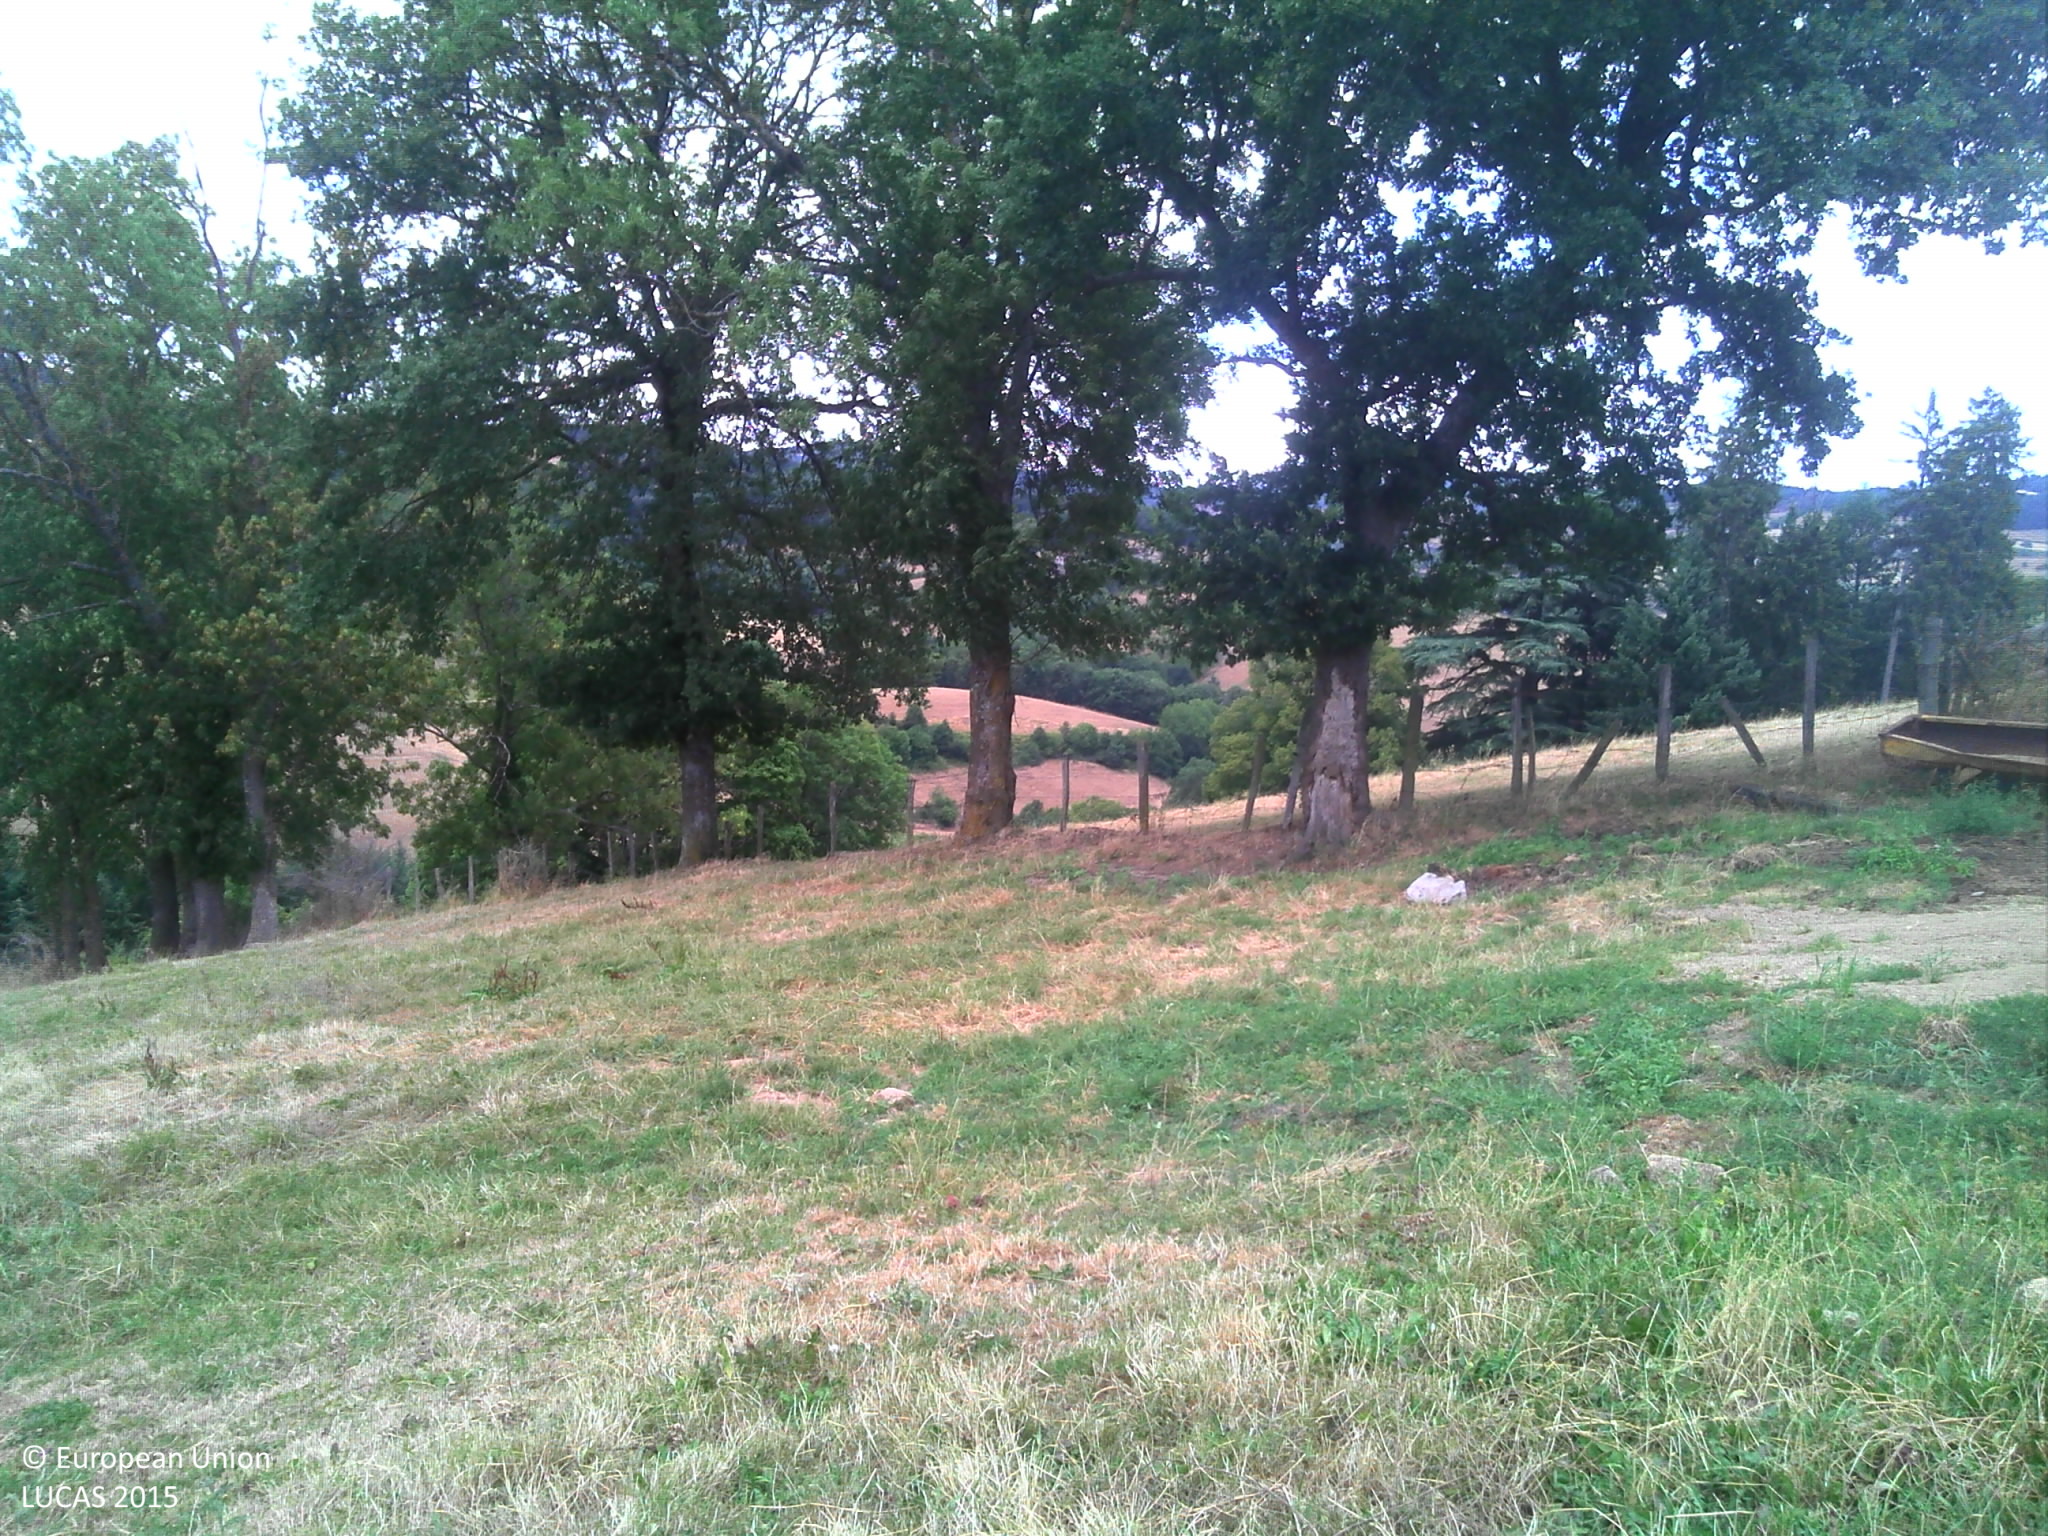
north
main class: Grassland
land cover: Grassland without tree/shrub cover
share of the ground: > 75 %
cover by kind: herbaceous plants 100 %
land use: Agriculture (excluding fallow land and kitchen gardens)
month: July
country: FR
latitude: 45.7564
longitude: 4.4621
